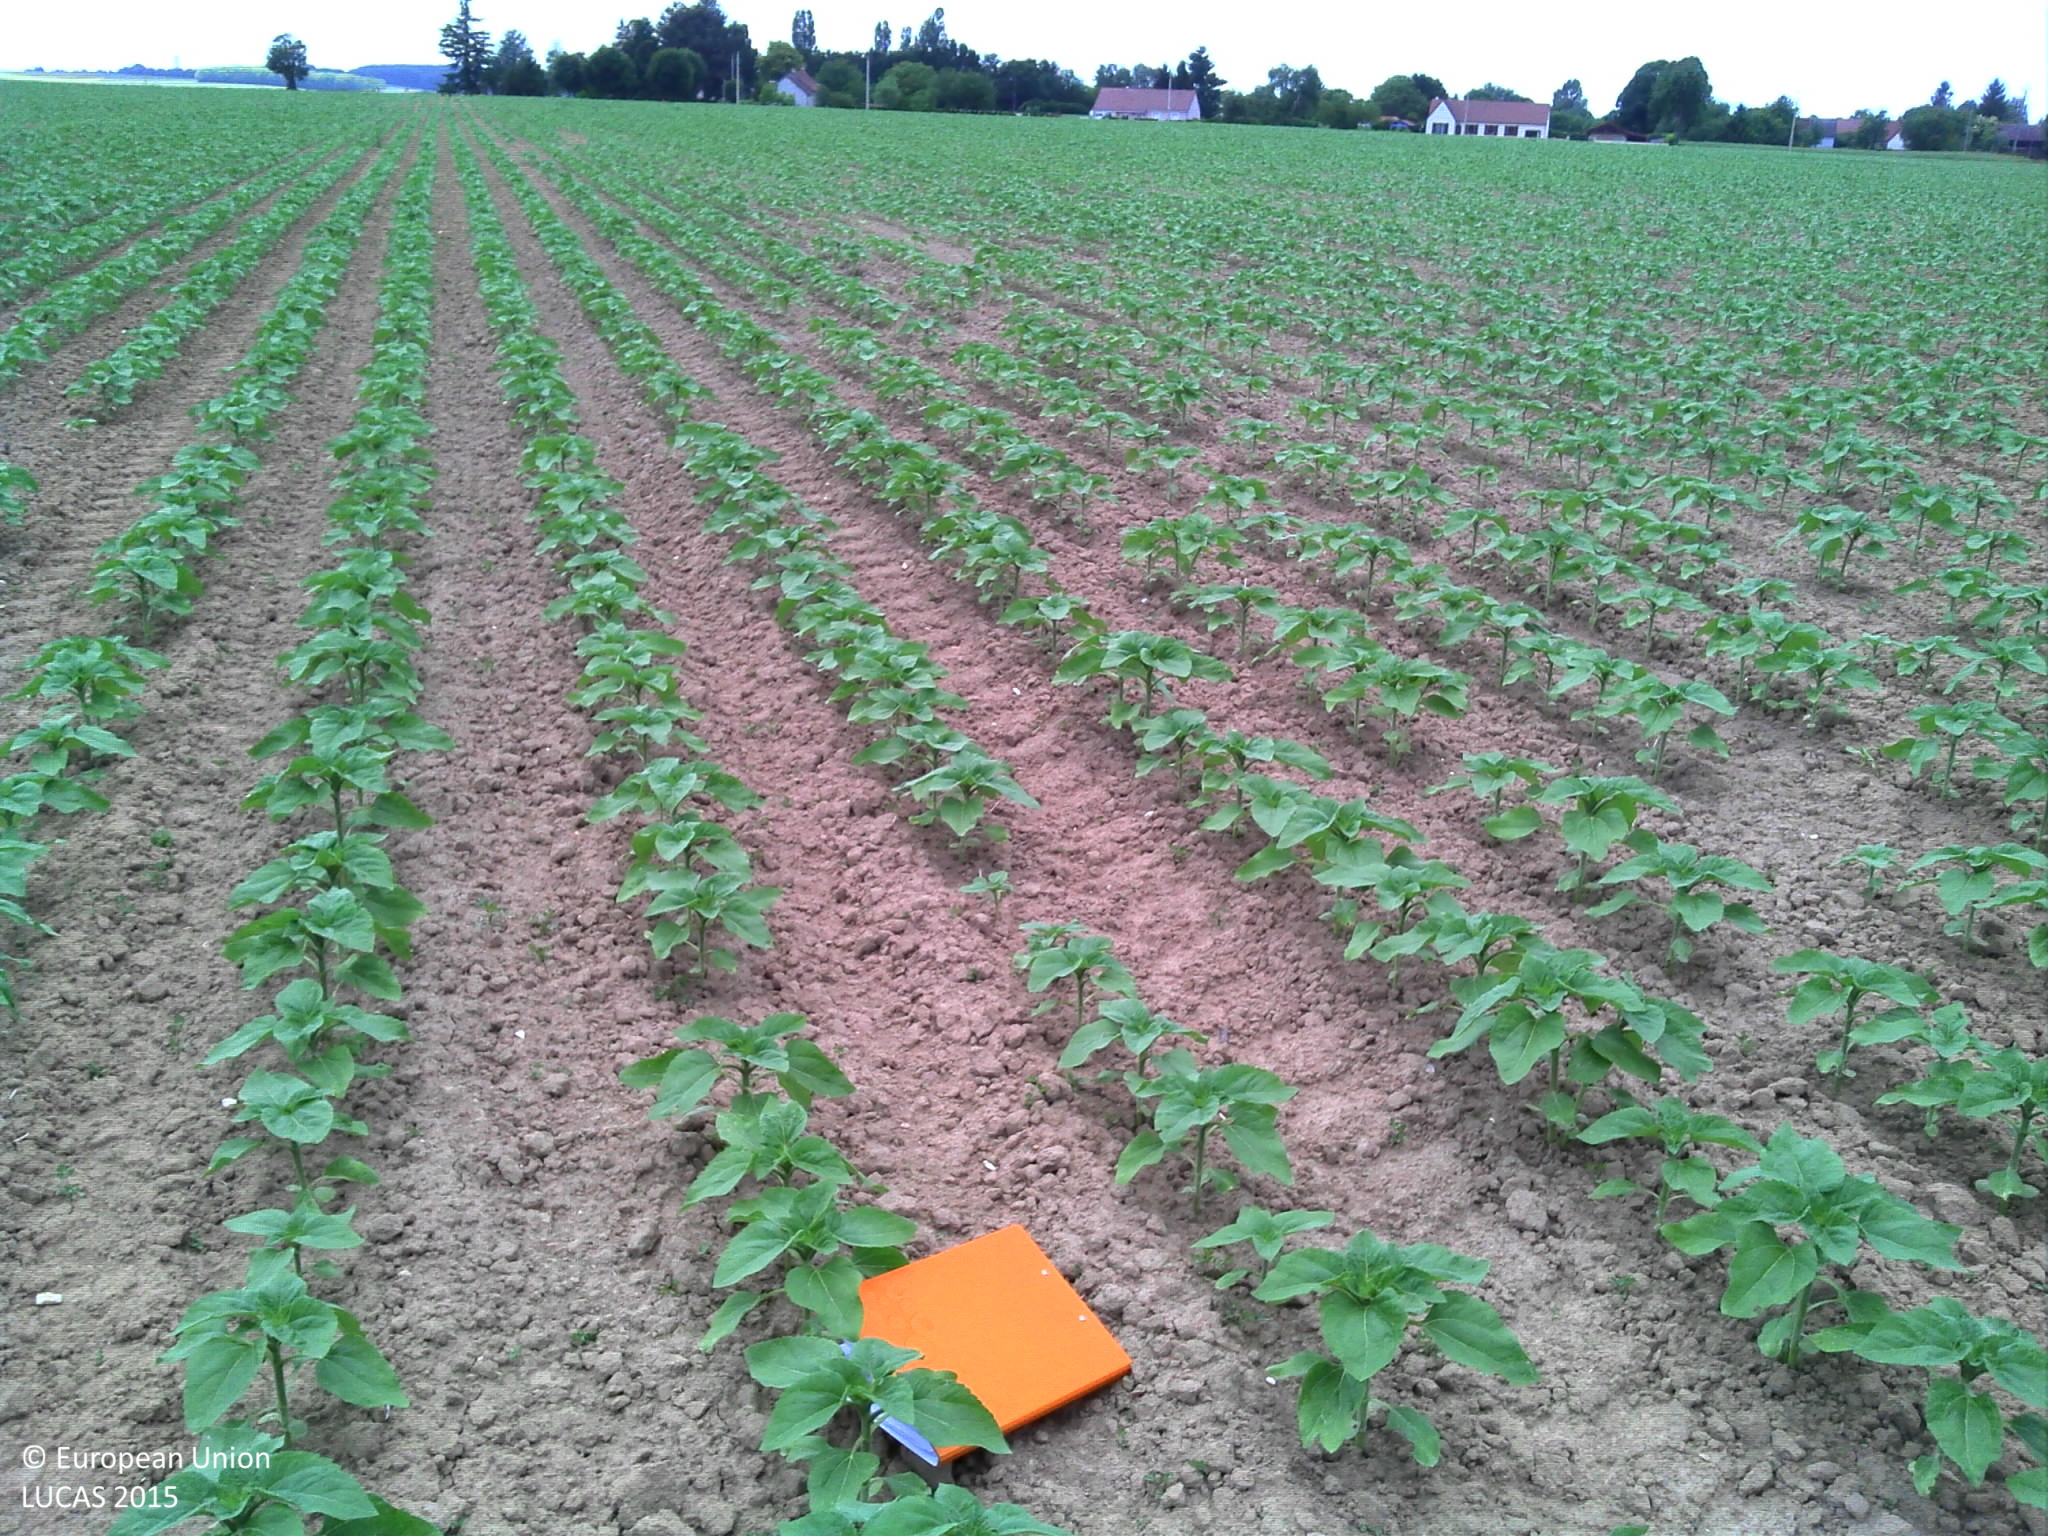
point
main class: Cropland
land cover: Sunflower
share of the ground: 25 - 50 %
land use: Agriculture (excluding fallow land and kitchen gardens)
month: May
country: FR
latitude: 47.1659
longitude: 2.9372
